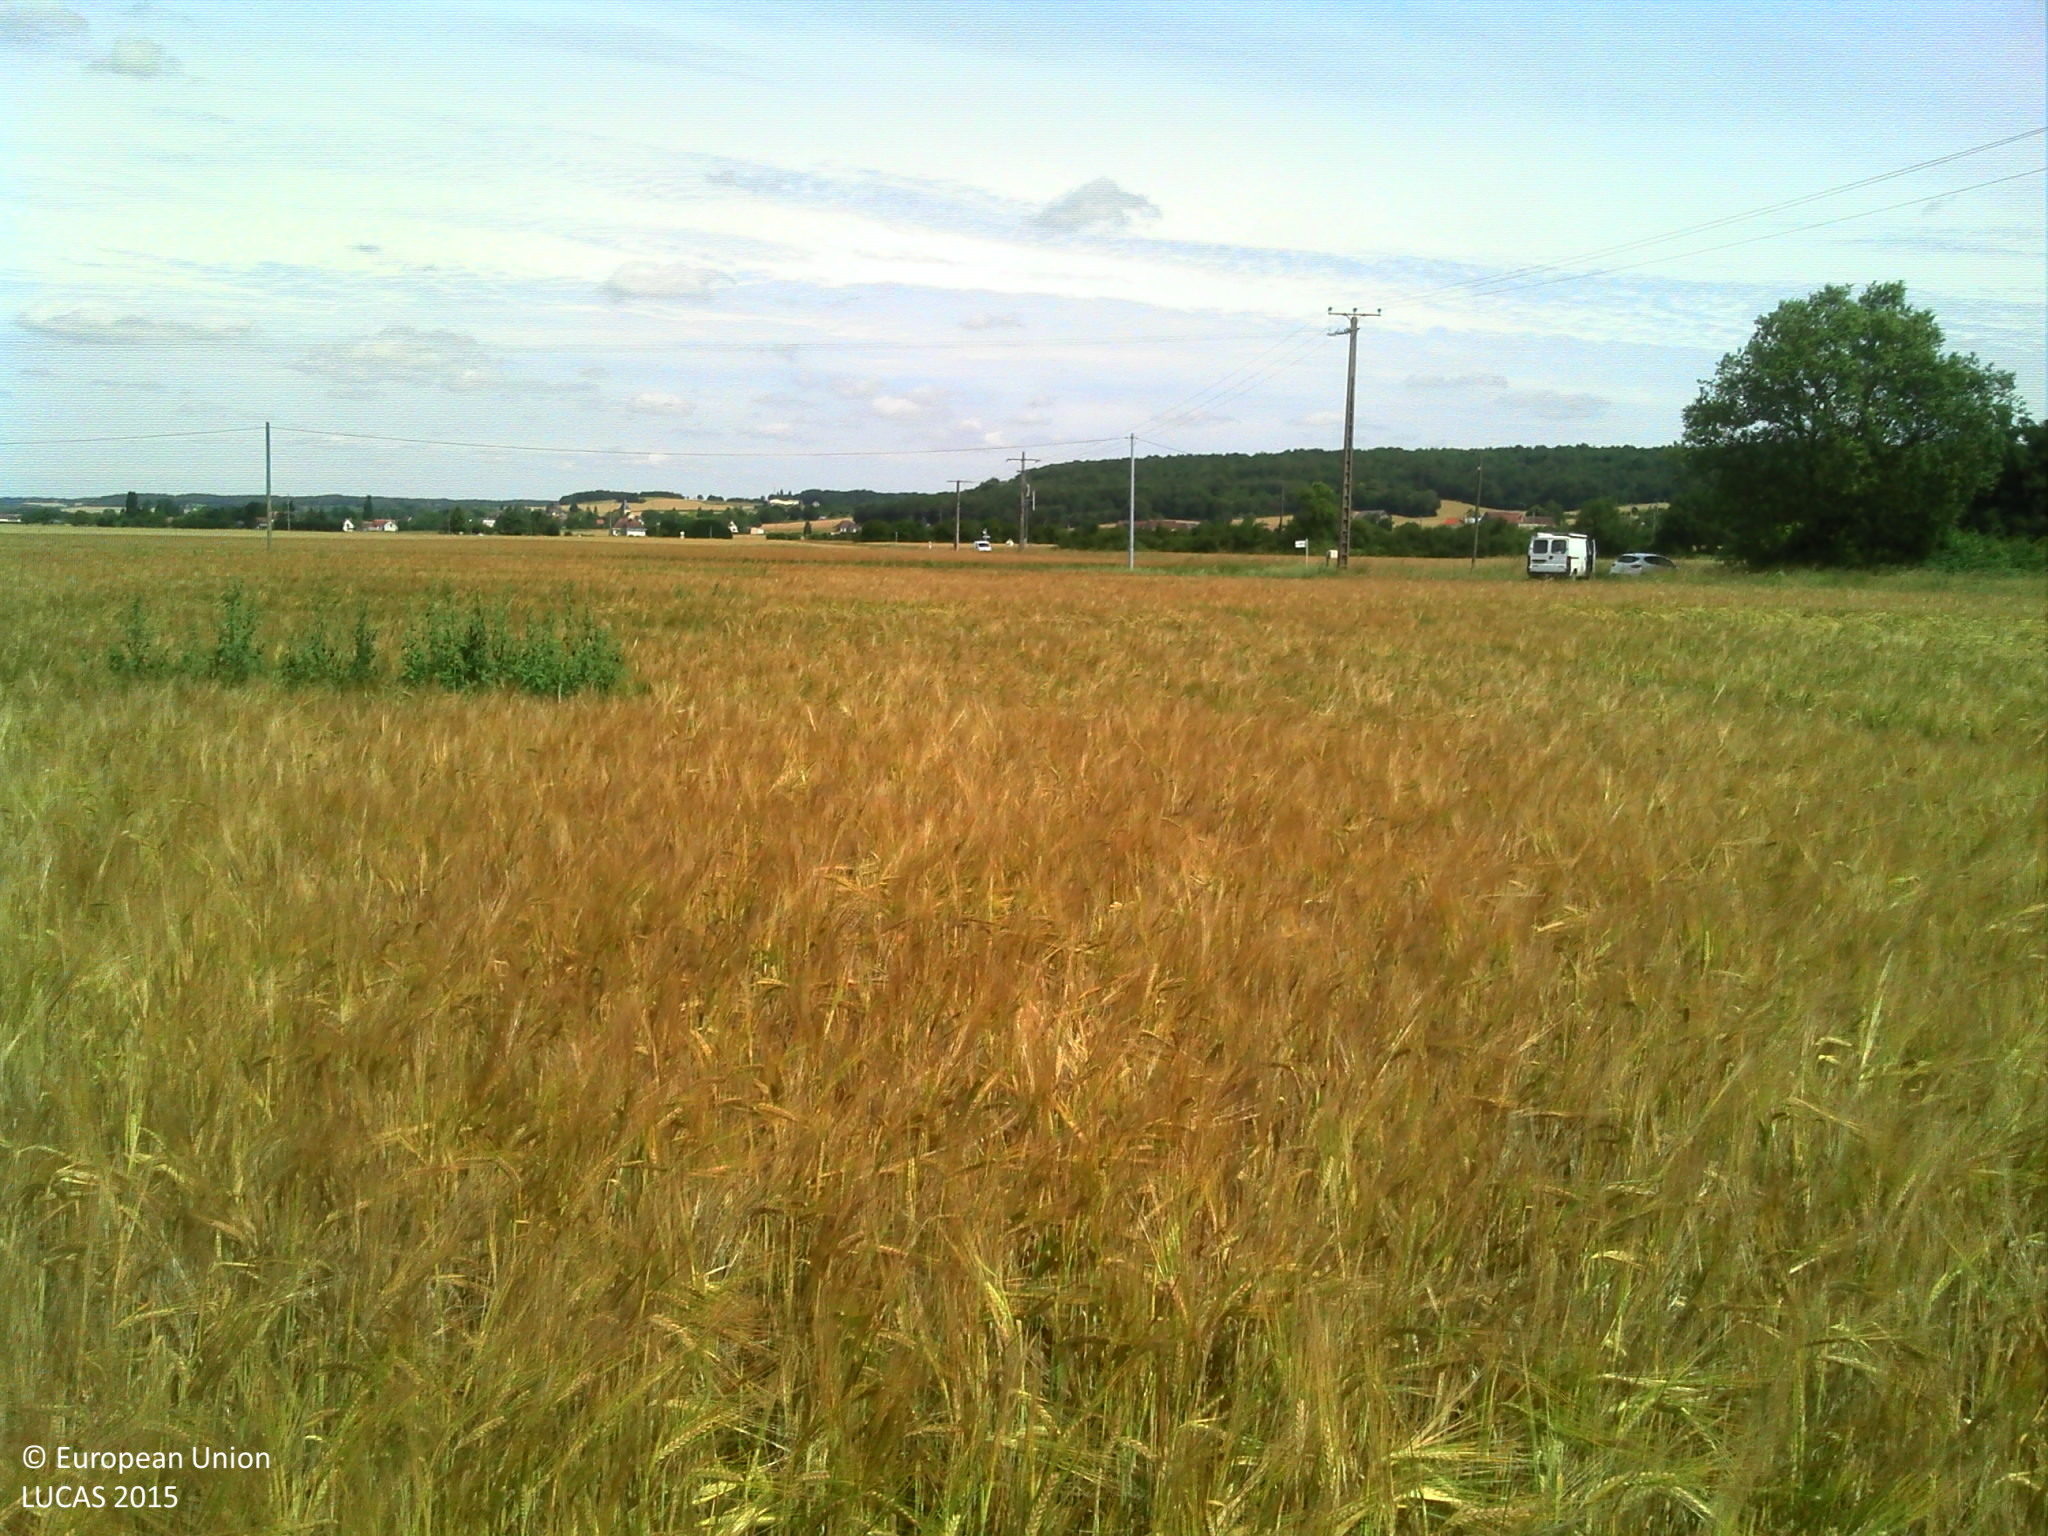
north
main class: Cropland
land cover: Barley
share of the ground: > 75 %
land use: Agriculture (excluding fallow land and kitchen gardens)
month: June
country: FR
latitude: 46.8256
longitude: 0.8208
